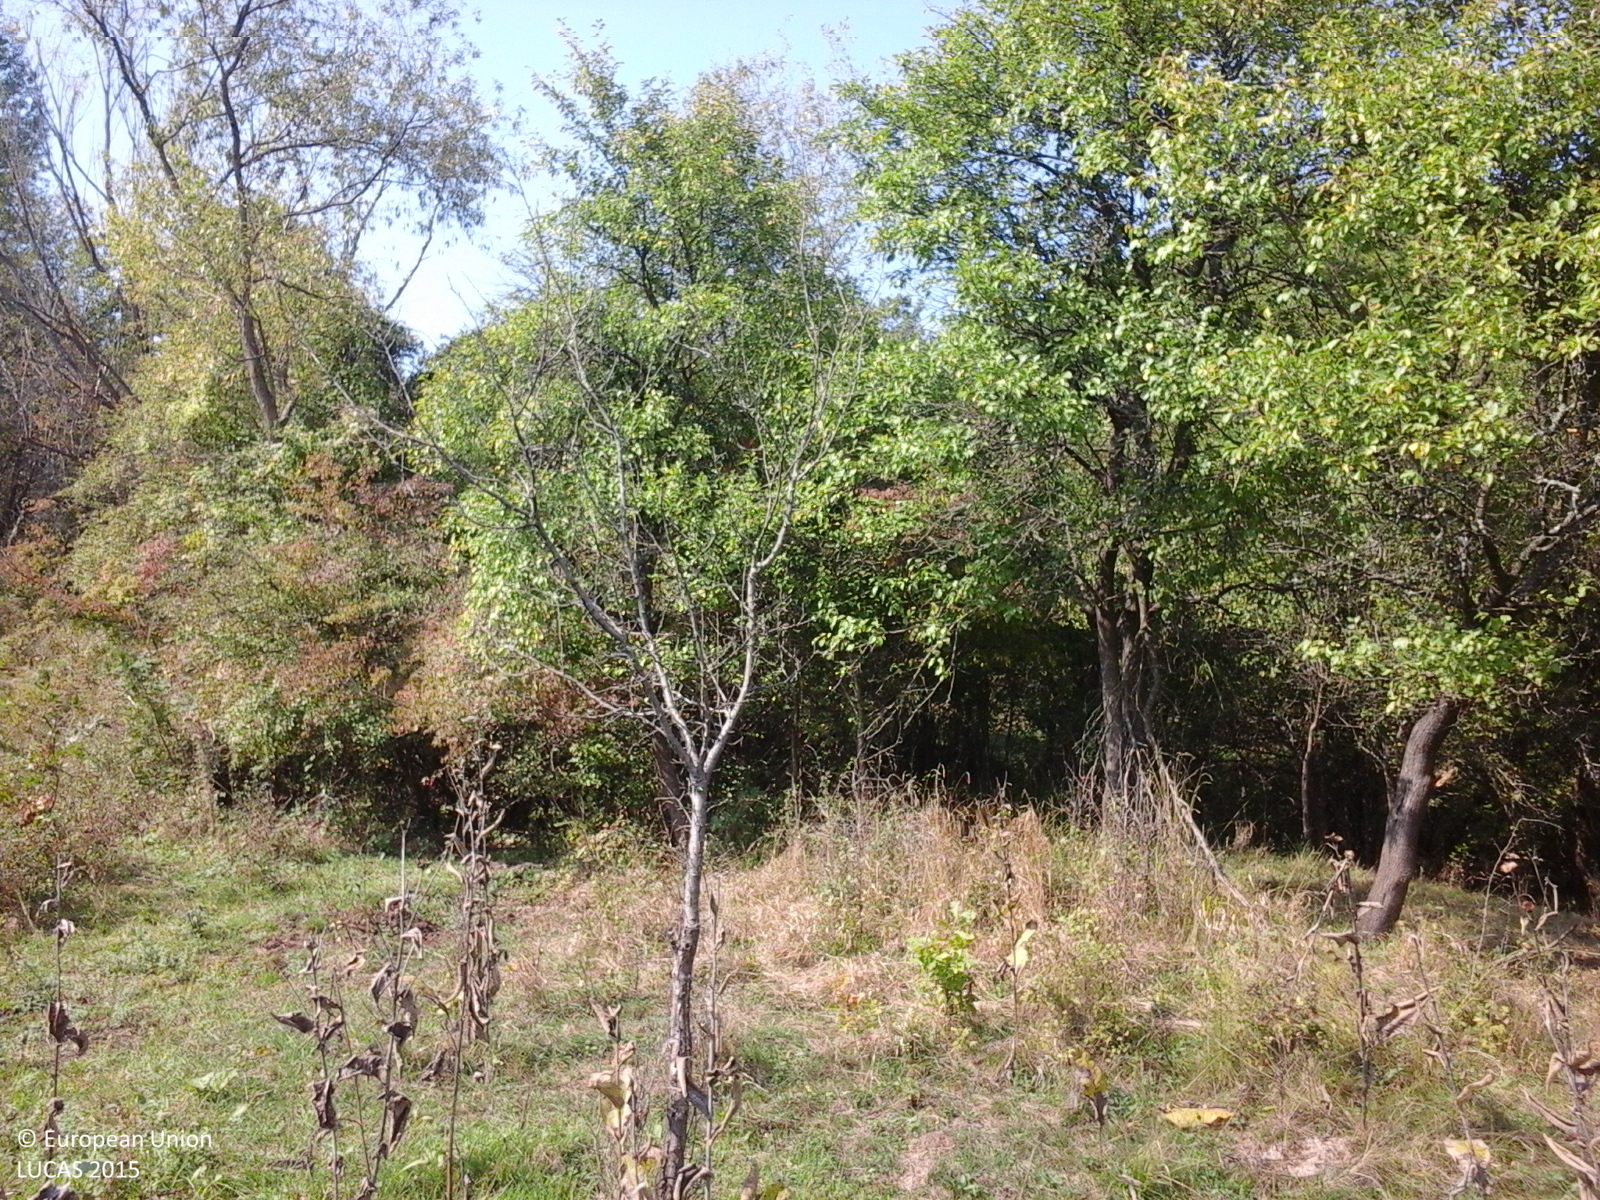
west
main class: Grassland
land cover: Spontaneously vegetated surfaces
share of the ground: > 75 %
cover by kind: herbaceous plants 100 %
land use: Fallow land
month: September
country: RO
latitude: 45.9680
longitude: 22.8947
